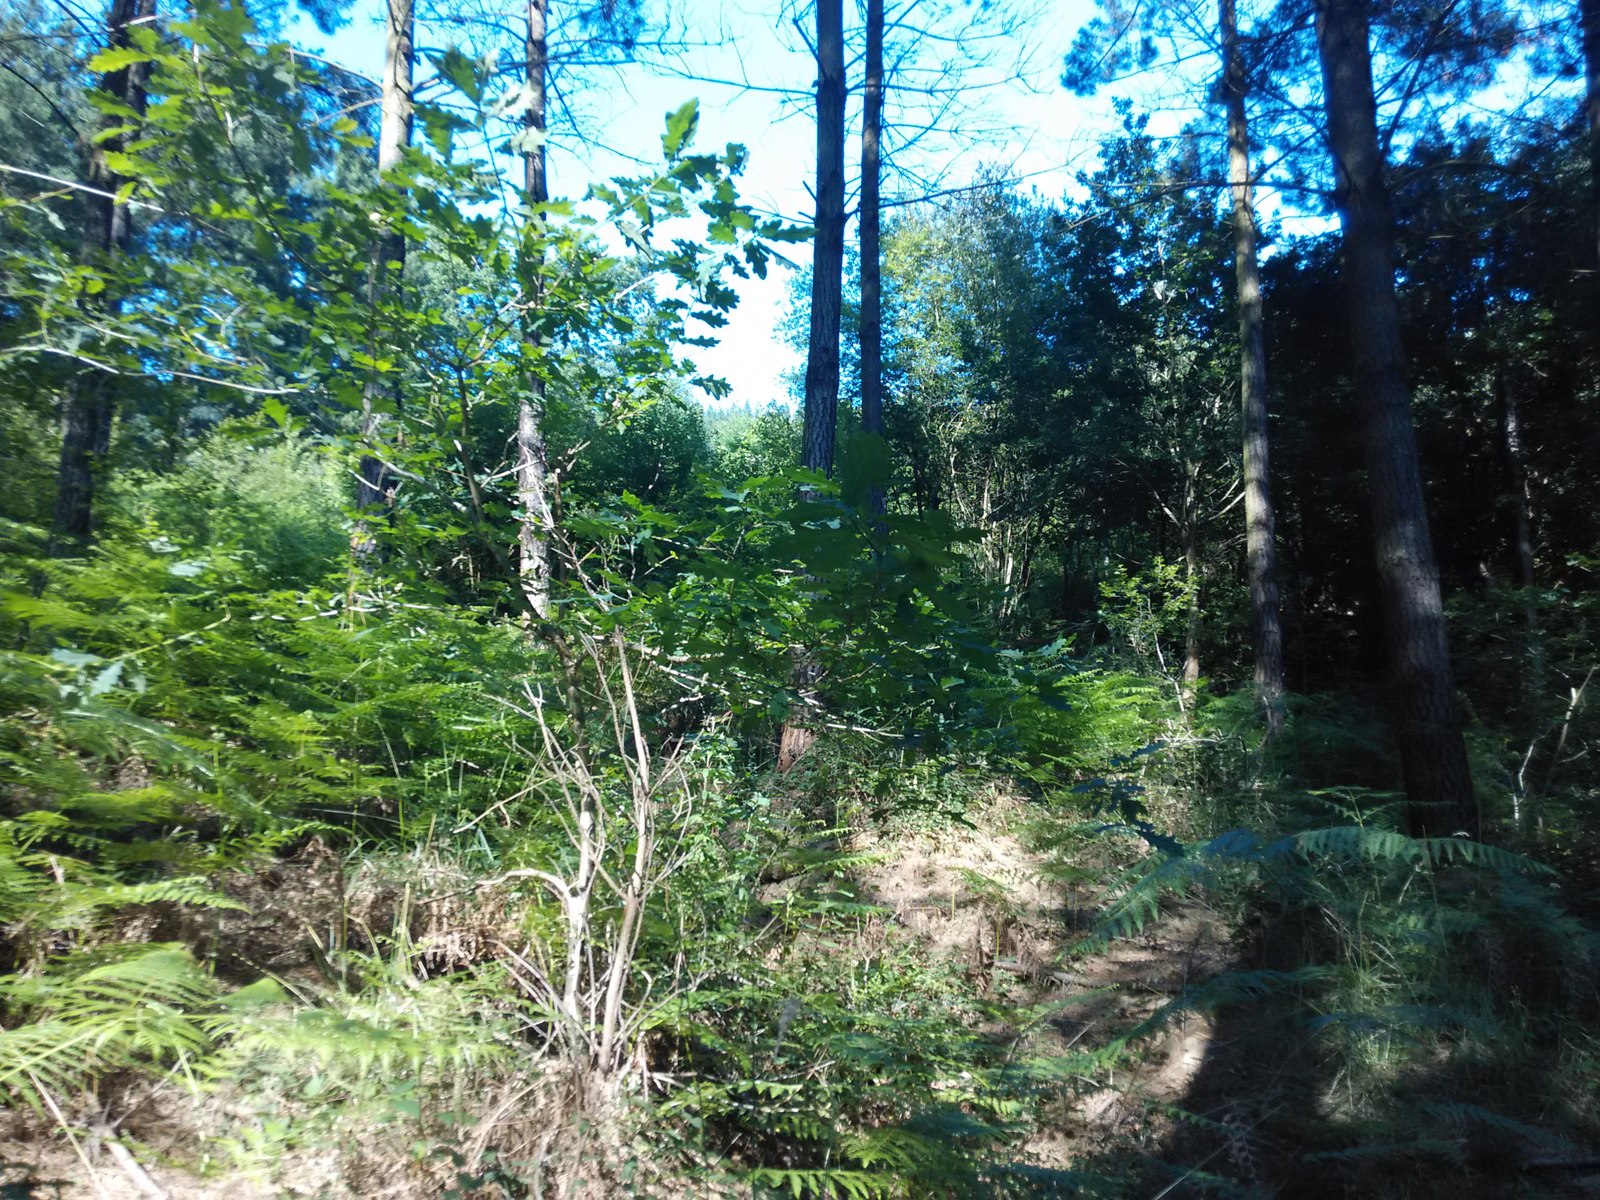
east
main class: Woodland
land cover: Pine dominated coniferous woodland
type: exotic forest
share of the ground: > 75 %
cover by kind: coniferous forest trees 100 %
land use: Forestry
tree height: > 5 m
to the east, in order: Pine dominated coniferous woodland; Tracks; Shrubland with sparse tree cover; Fences; Paved roads, cycling and walking lanes; Fences; Grassland without tree/shrub cover; Fences; Tracks; Pine dominated coniferous woodland; Tracks; Pine dominated coniferous woodland
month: June
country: ES
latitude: 43.0815
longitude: -2.4939
